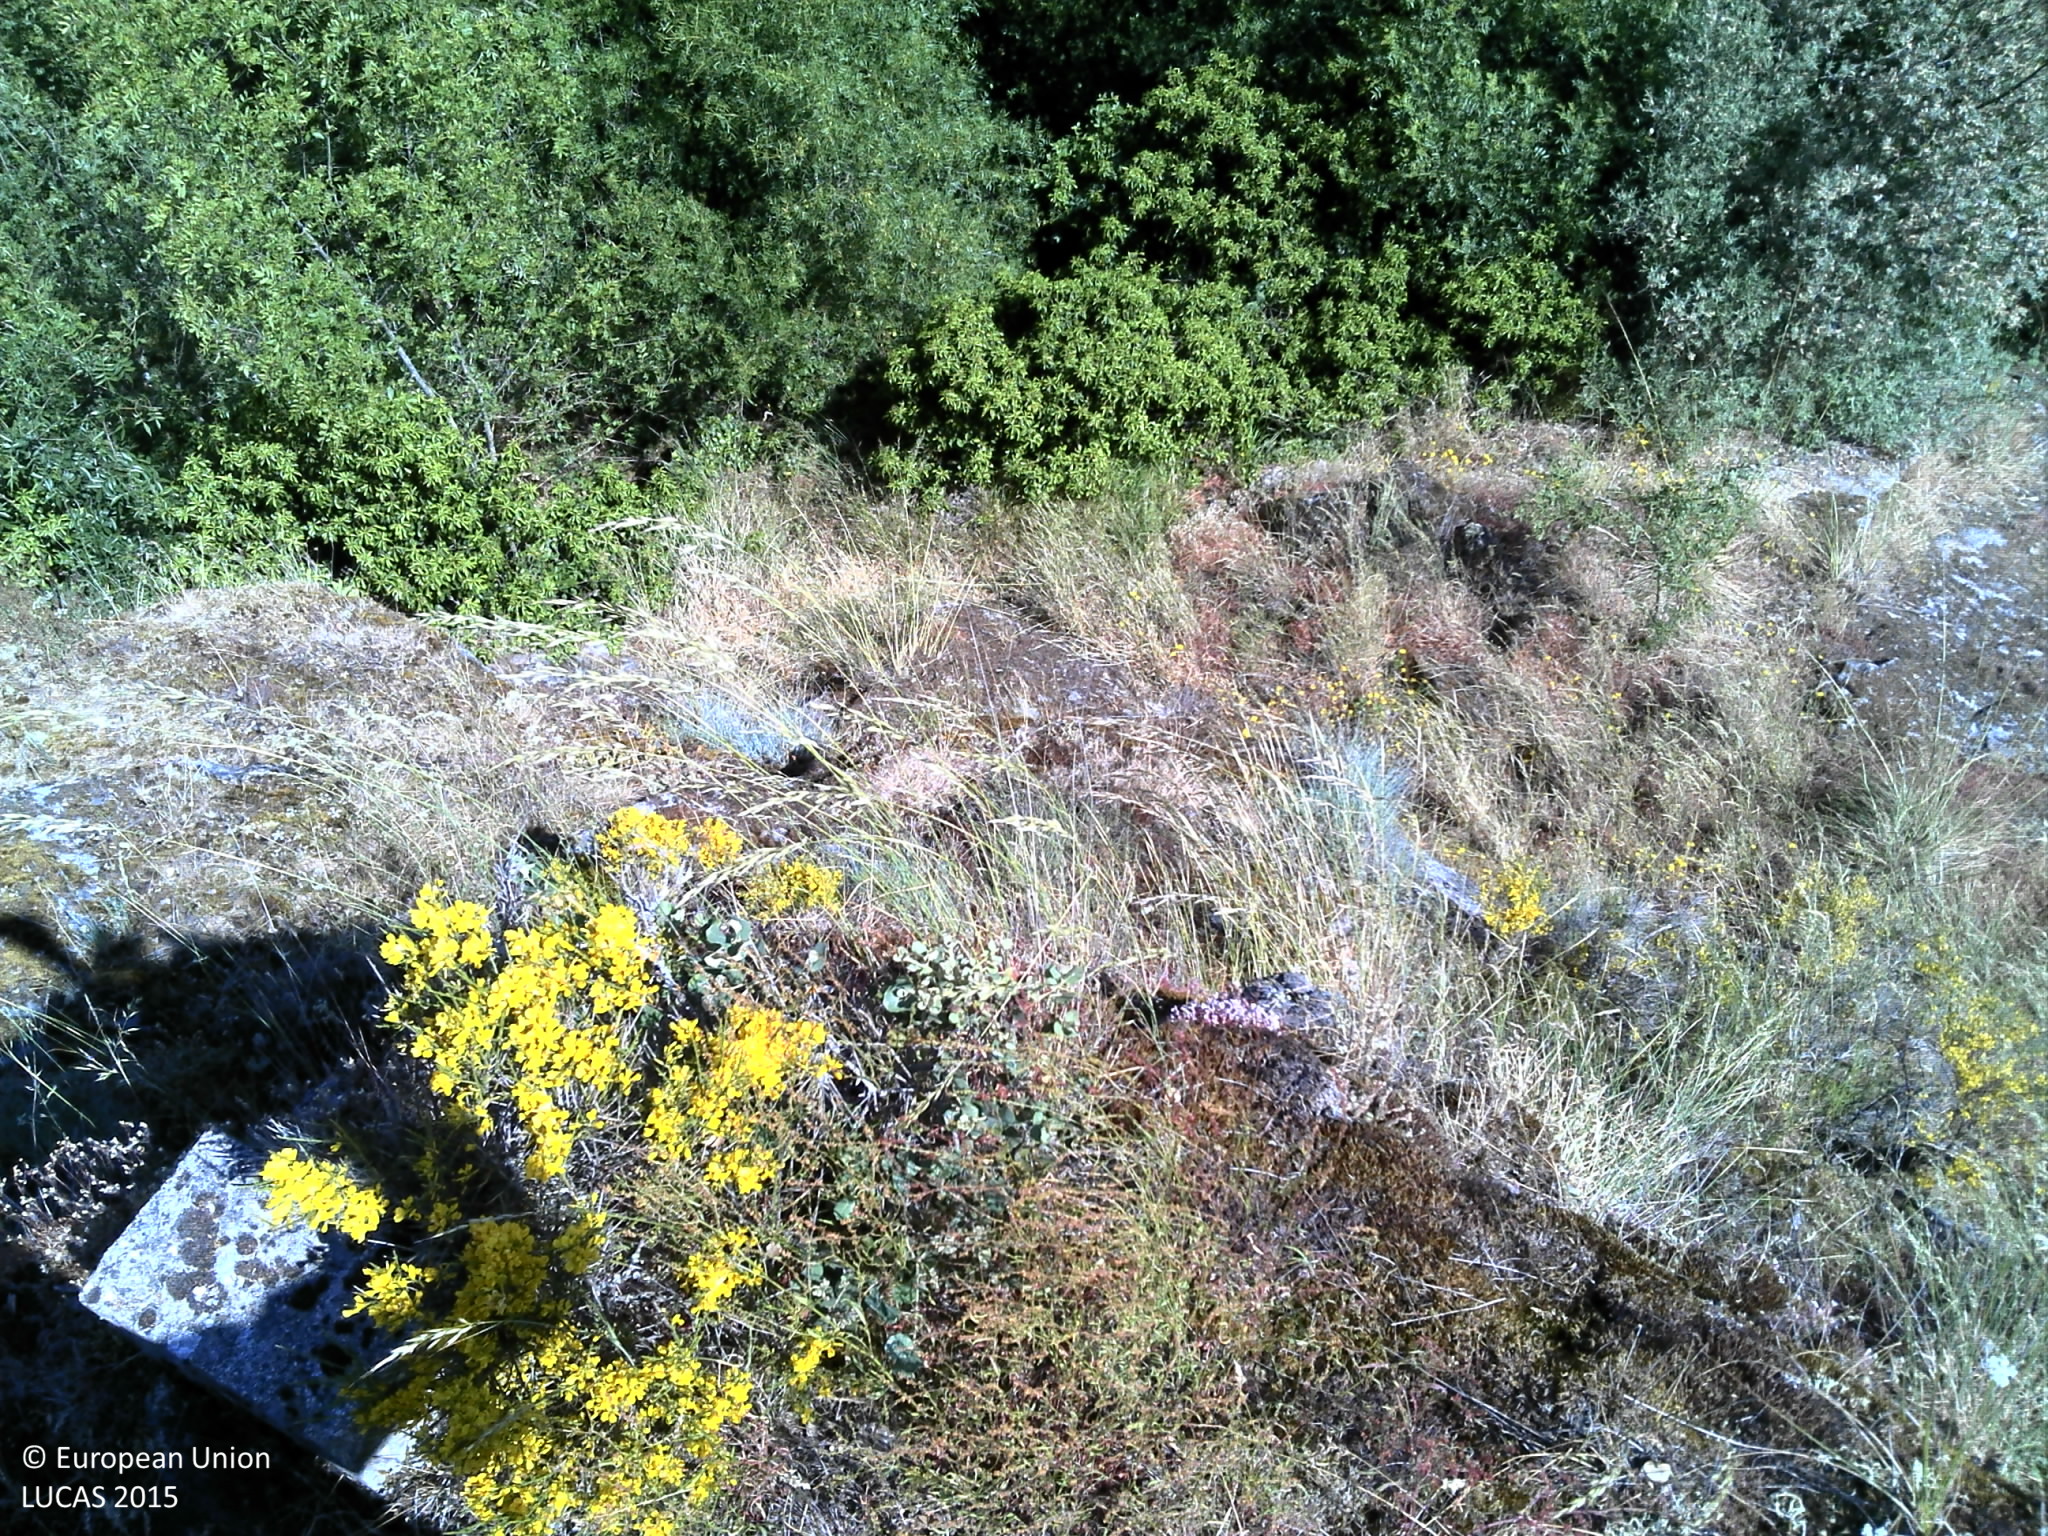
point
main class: Grassland
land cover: Grassland with sparse tree/shrub cover
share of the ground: 50 - 75 %
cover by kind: herbaceous plants 50 %, consolidated bare surface 45 %, broadleaved forest trees 5 %
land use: Semi-natural and natural areas not in use
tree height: > 5 m
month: May
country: PT
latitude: 41.4920
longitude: -6.2799
